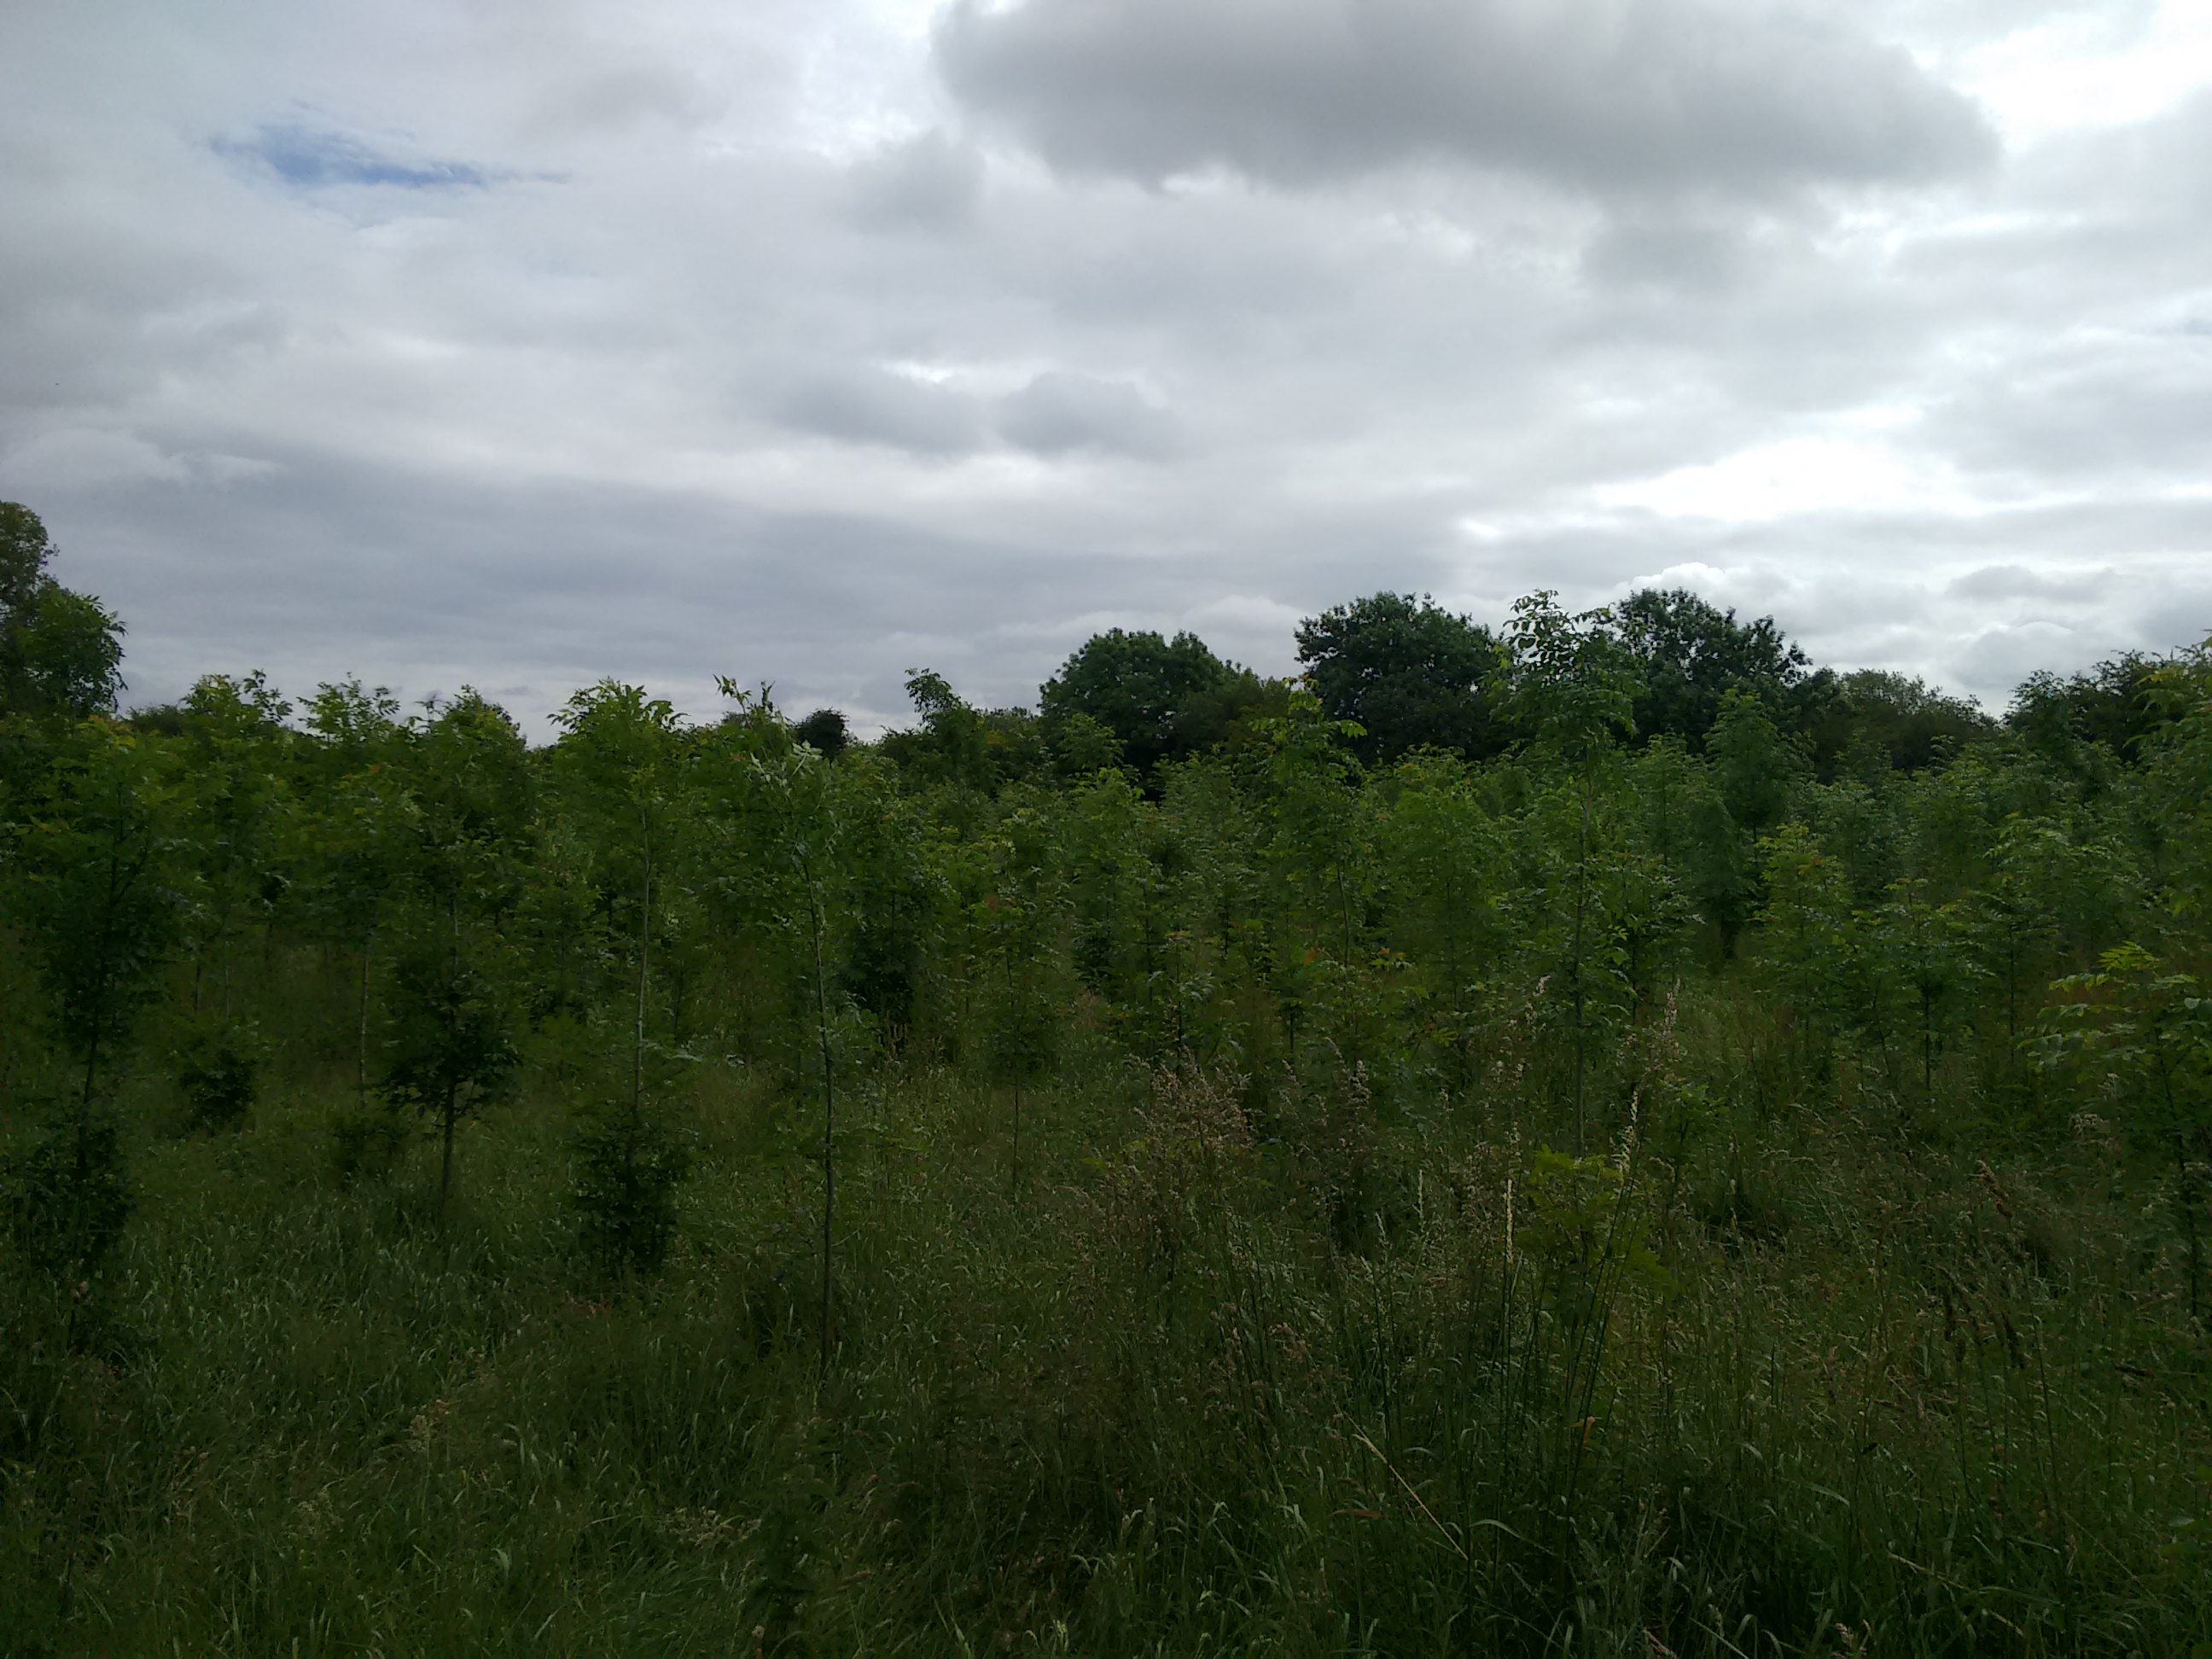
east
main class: Woodland
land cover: Broadleaved woodland
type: acidophilous oak and oak-birch forest
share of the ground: 50 - 75 %
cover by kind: broadleaved forest trees 70 %, herbaceous plants 30 %
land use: Forestry
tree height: < 5 m
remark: Nursery
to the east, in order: Broadleaved woodland; Fences; Shruby margins; Dry stone walls; Shrubland with sparse tree cover; Peatbogs
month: June
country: IE
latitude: 53.3245
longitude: -7.7785
